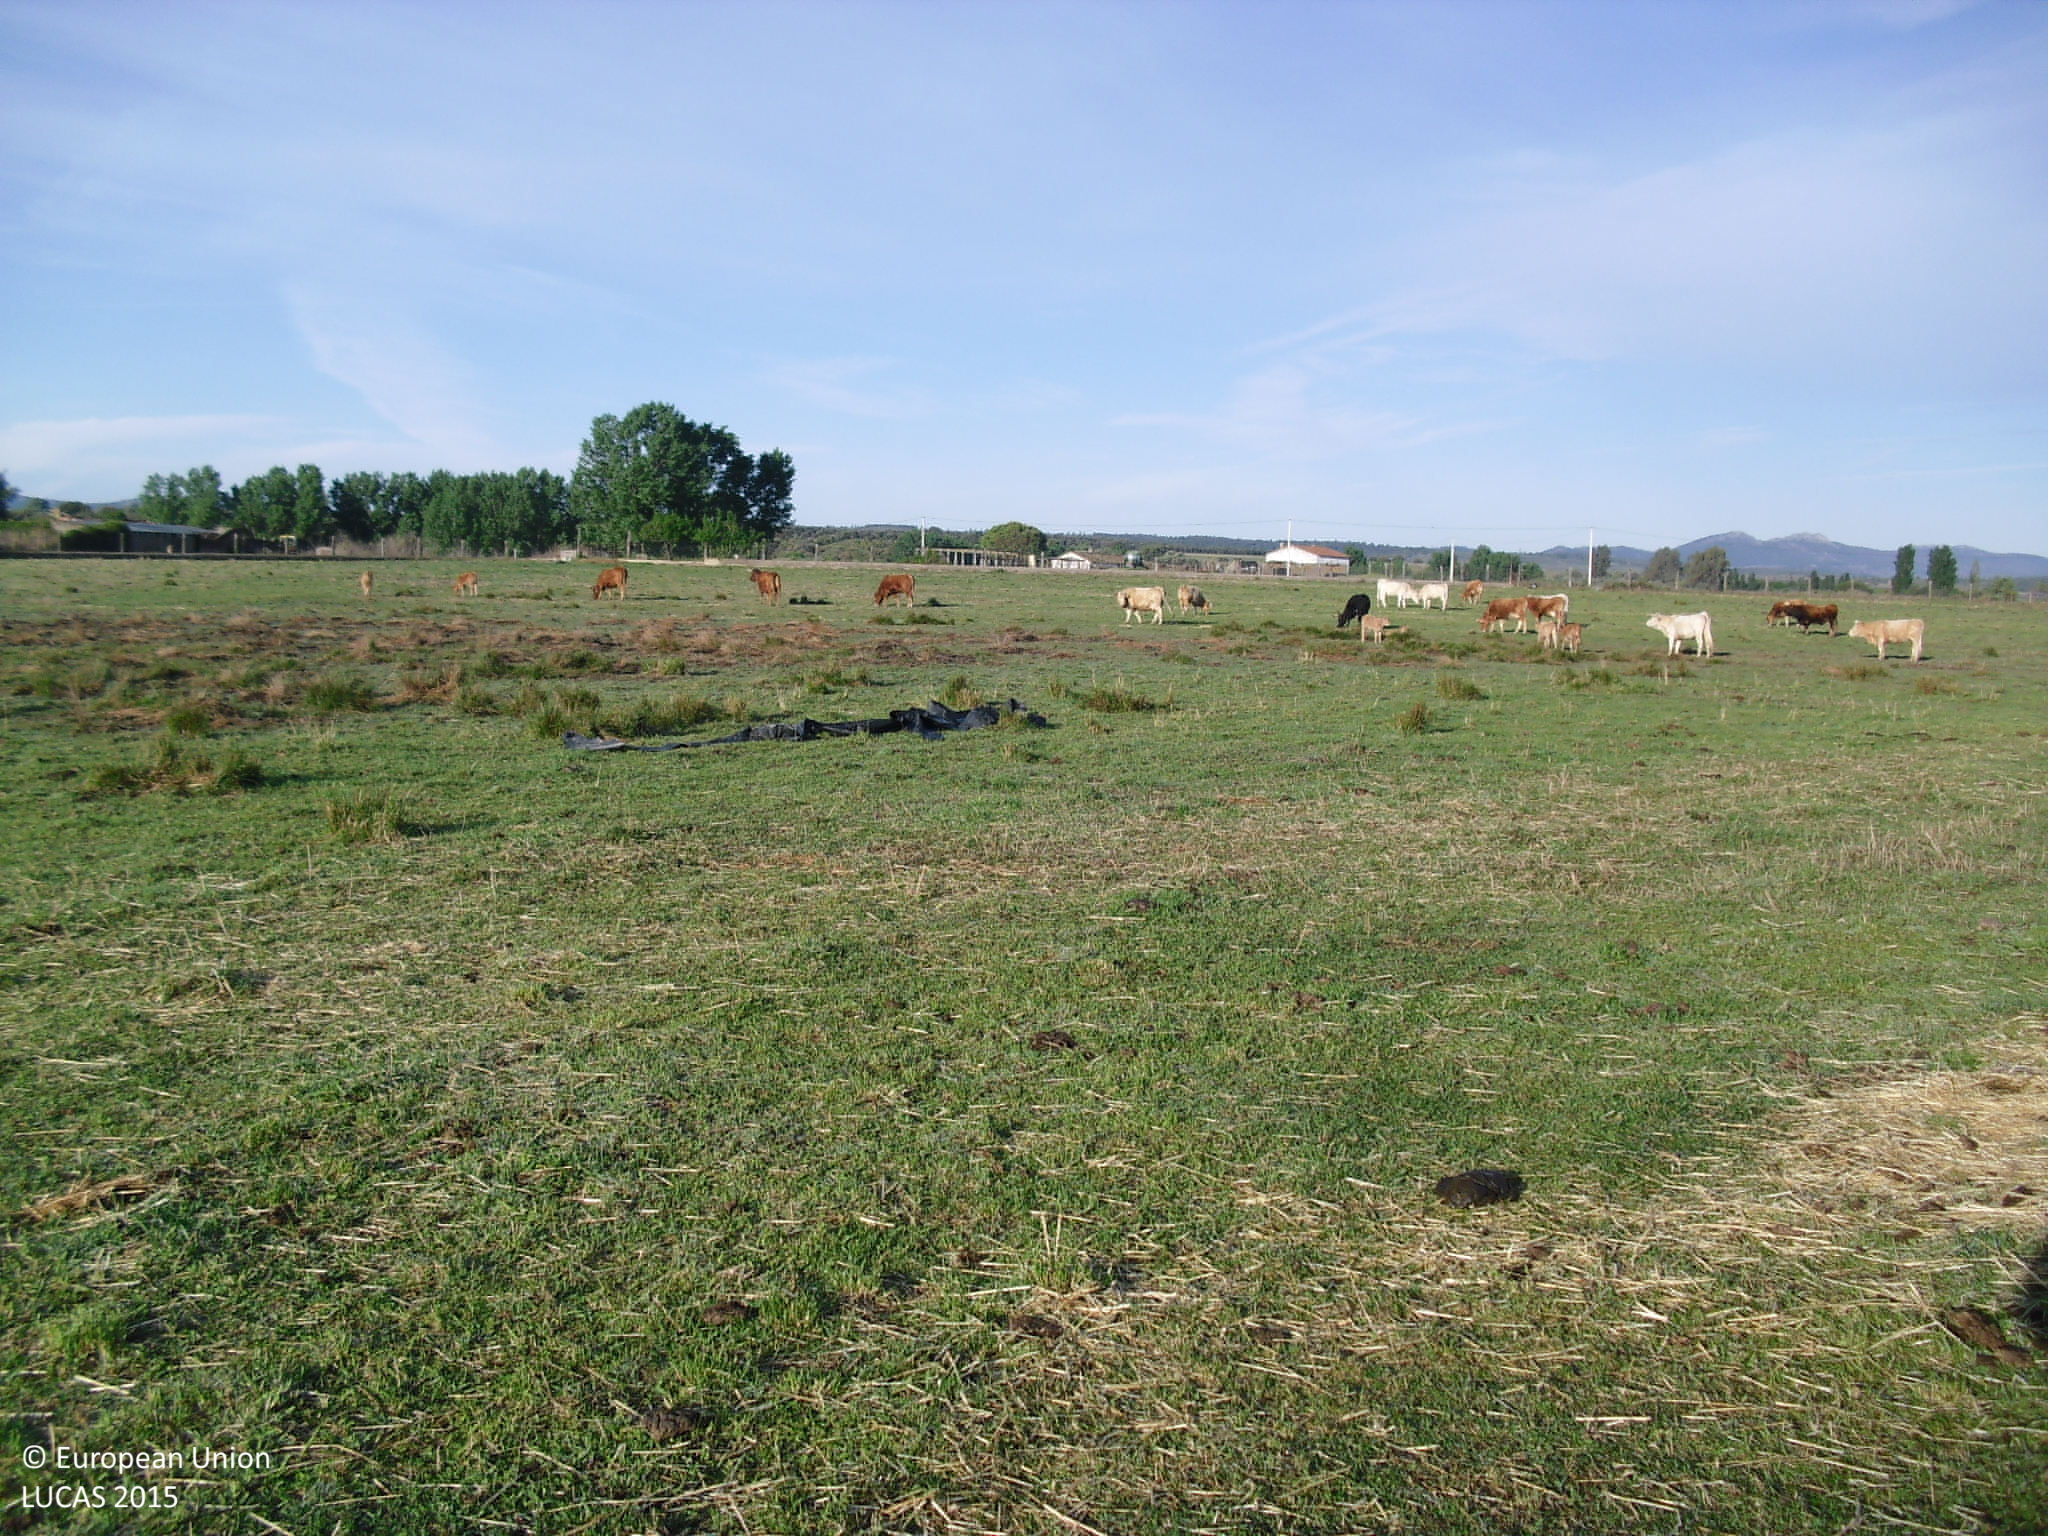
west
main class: Cropland
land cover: Temporary grasslands
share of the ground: > 75 %
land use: Agriculture (excluding fallow land and kitchen gardens)
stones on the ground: < 10 %
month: April
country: ES
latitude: 40.0478
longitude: -6.7656
